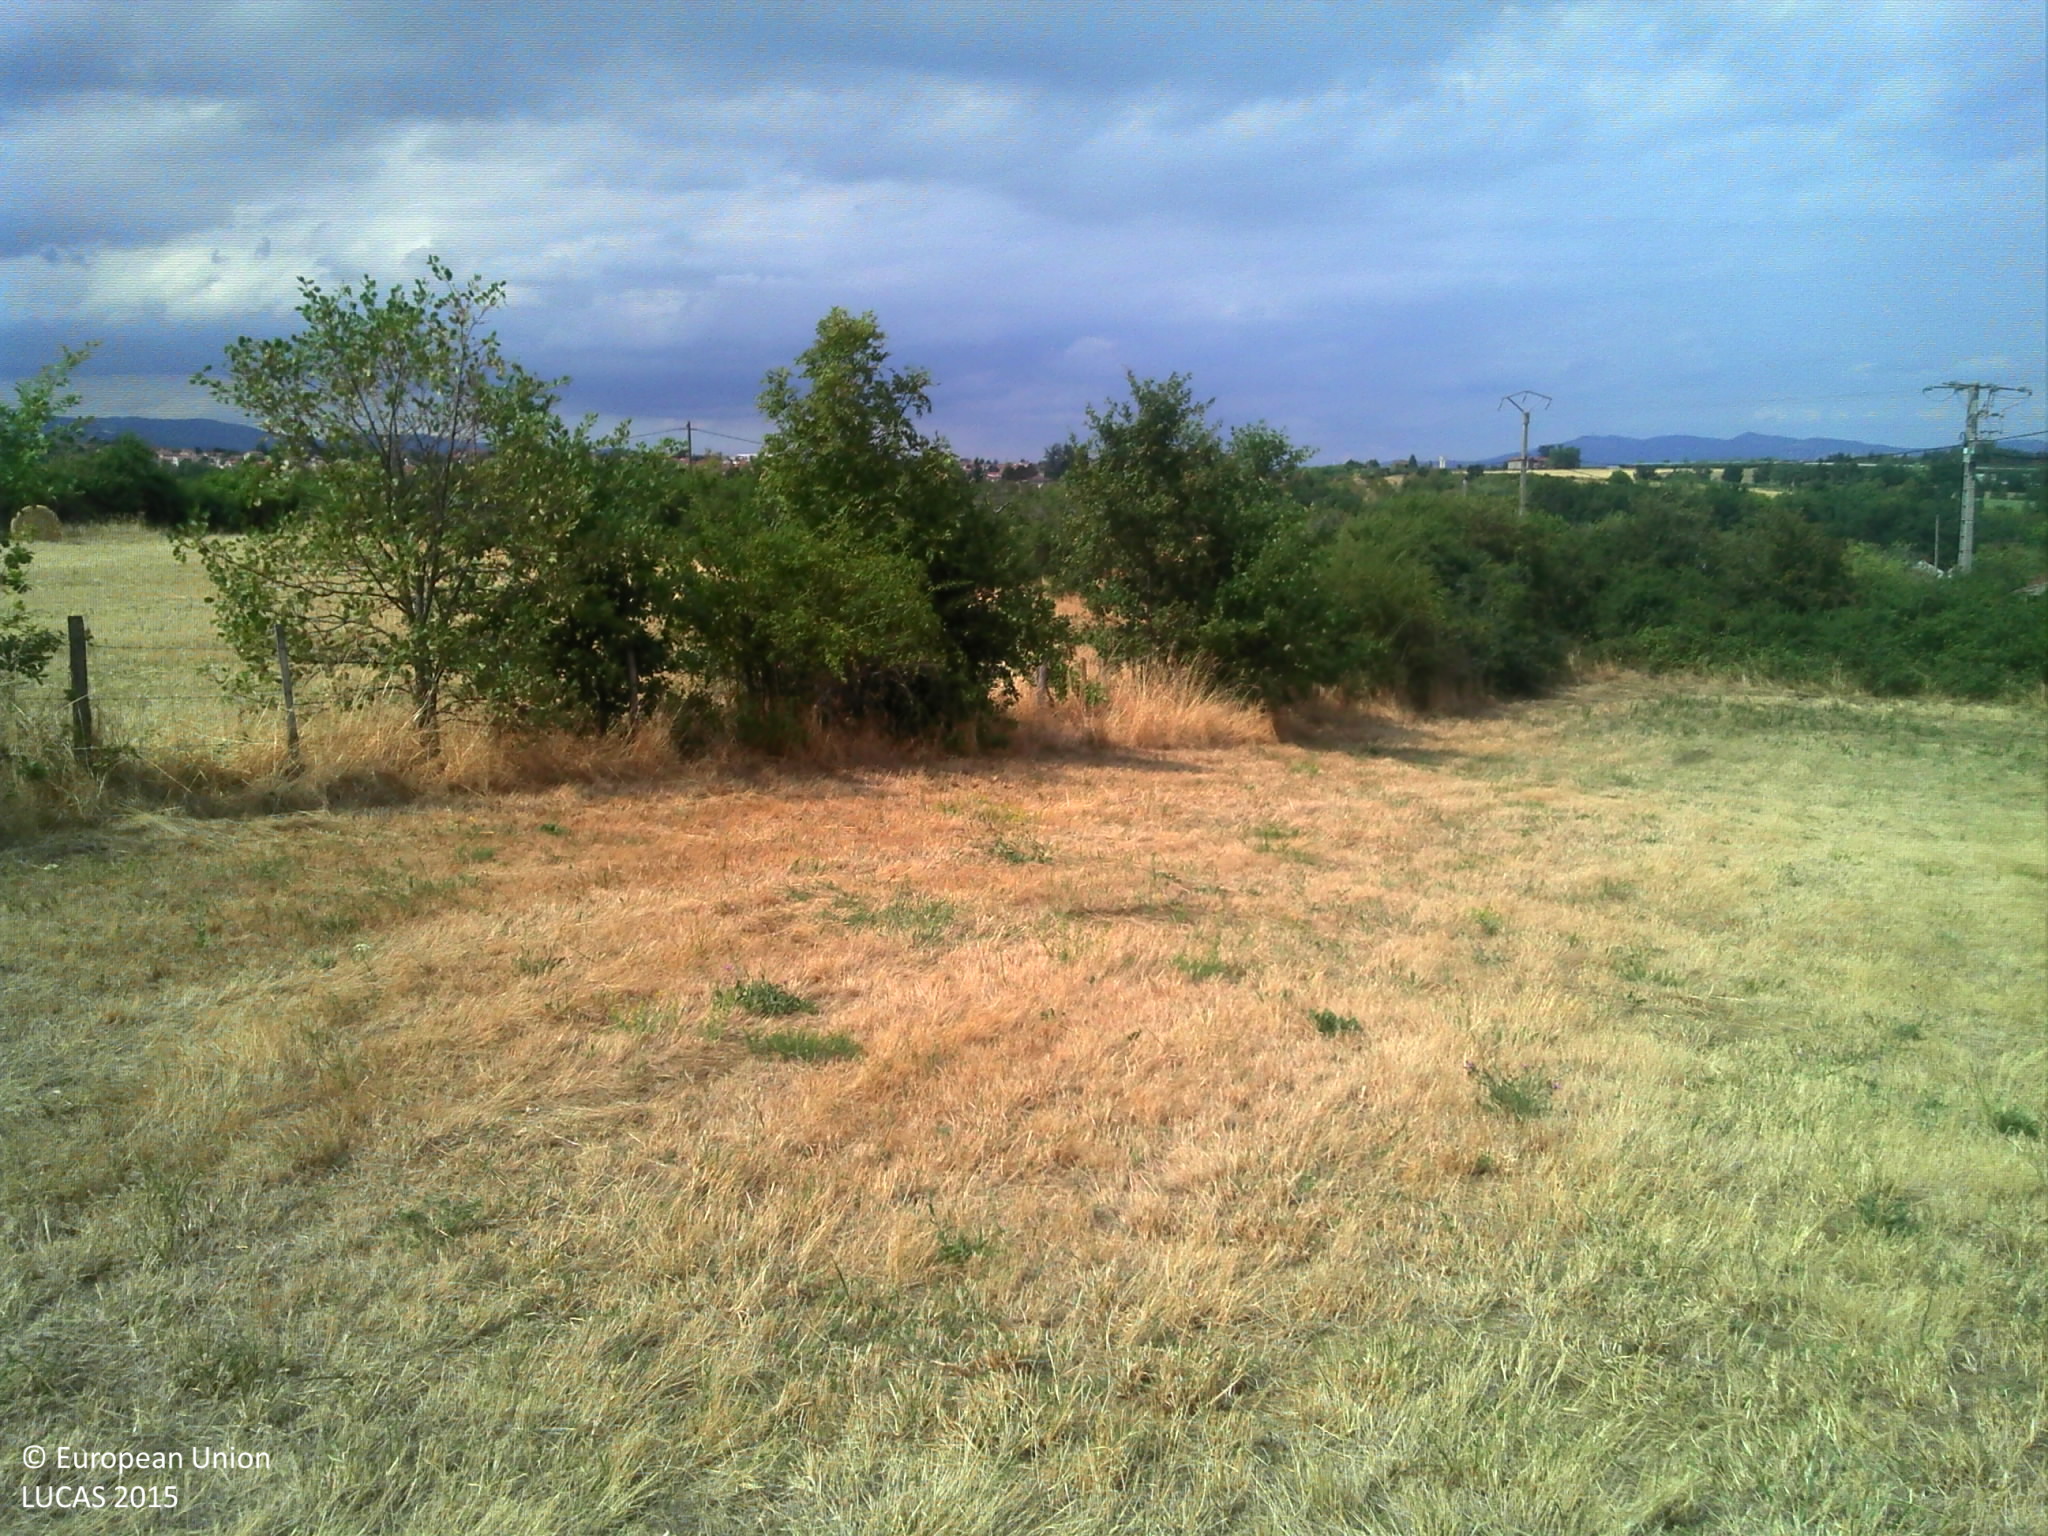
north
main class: Grassland
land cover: Grassland without tree/shrub cover
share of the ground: > 75 %
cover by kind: herbaceous plants 100 %
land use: Agriculture (excluding fallow land and kitchen gardens)
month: August
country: FR
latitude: 45.6604
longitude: 4.7031
